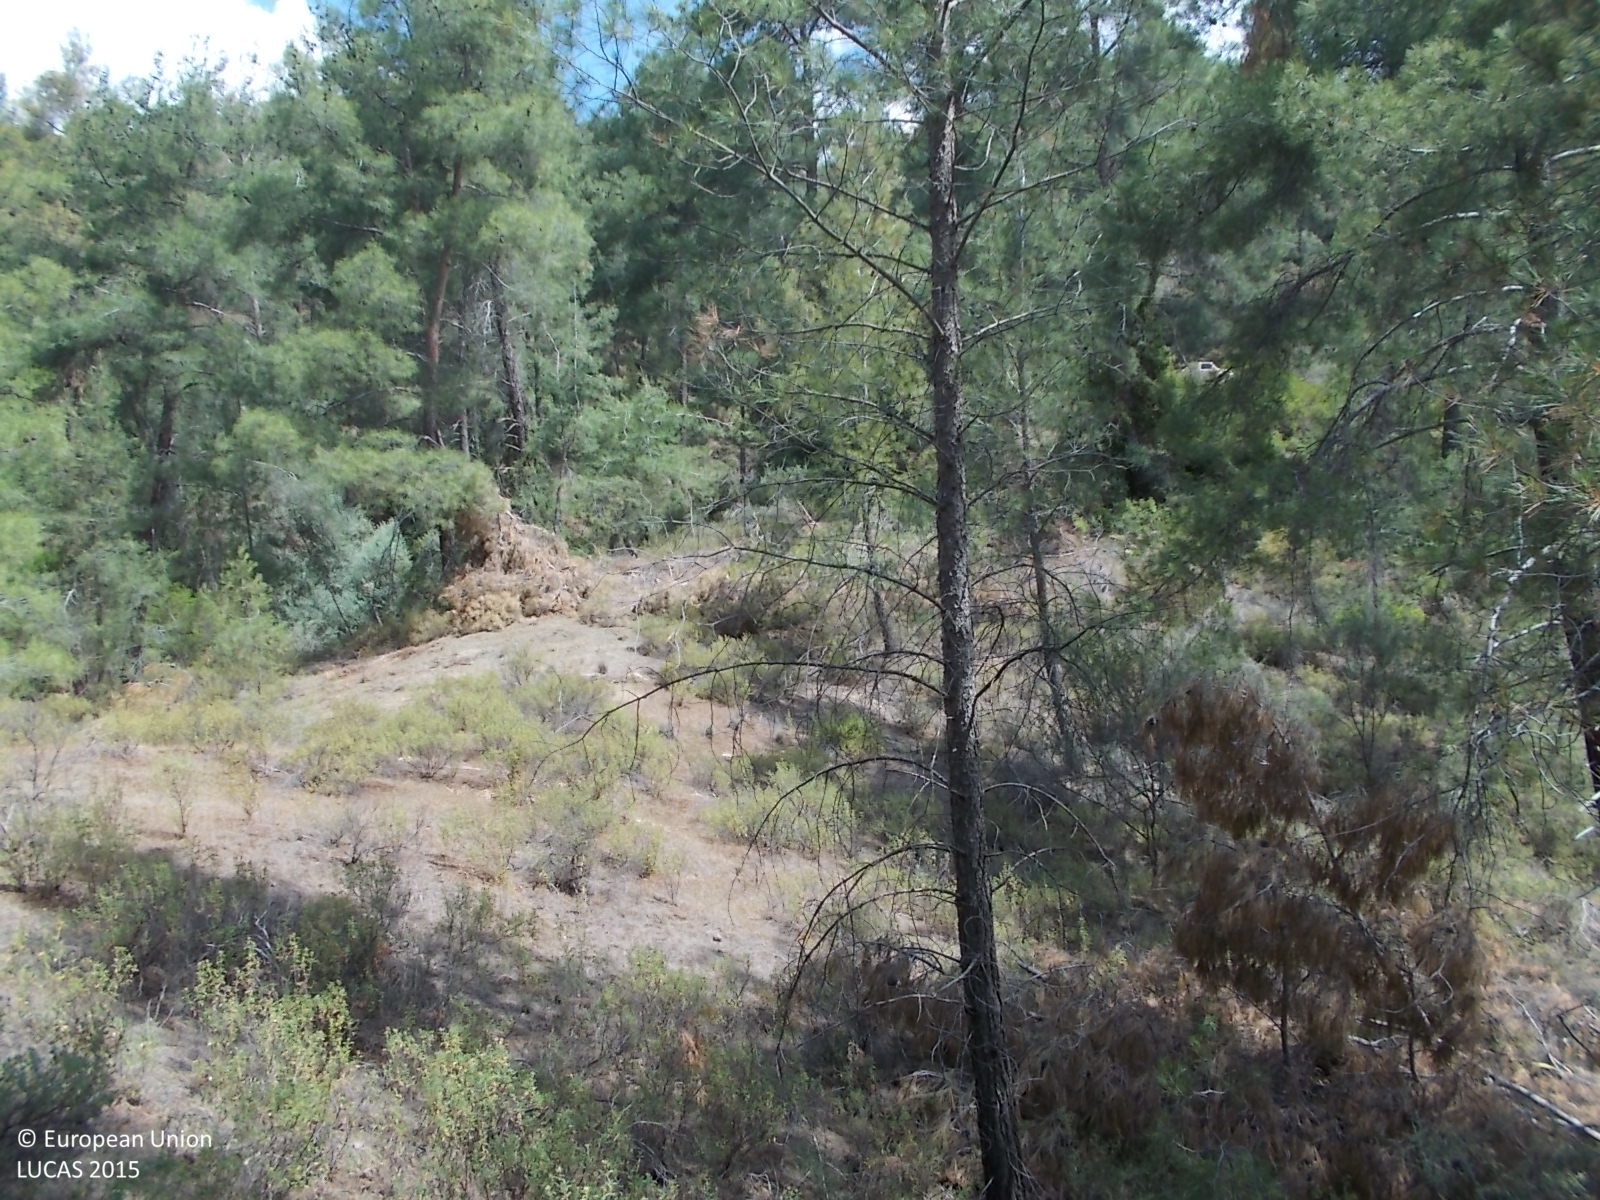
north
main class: Woodland
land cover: Pine dominated coniferous woodland
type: coniferous forest of the mediterranean region
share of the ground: > 75 %
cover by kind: coniferous forest trees 85 %, shrubs 10 %, unconsolidated bare surface 5 %
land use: Forestry
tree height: > 5 m
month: June
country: CY
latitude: 34.8878
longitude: 32.7784
